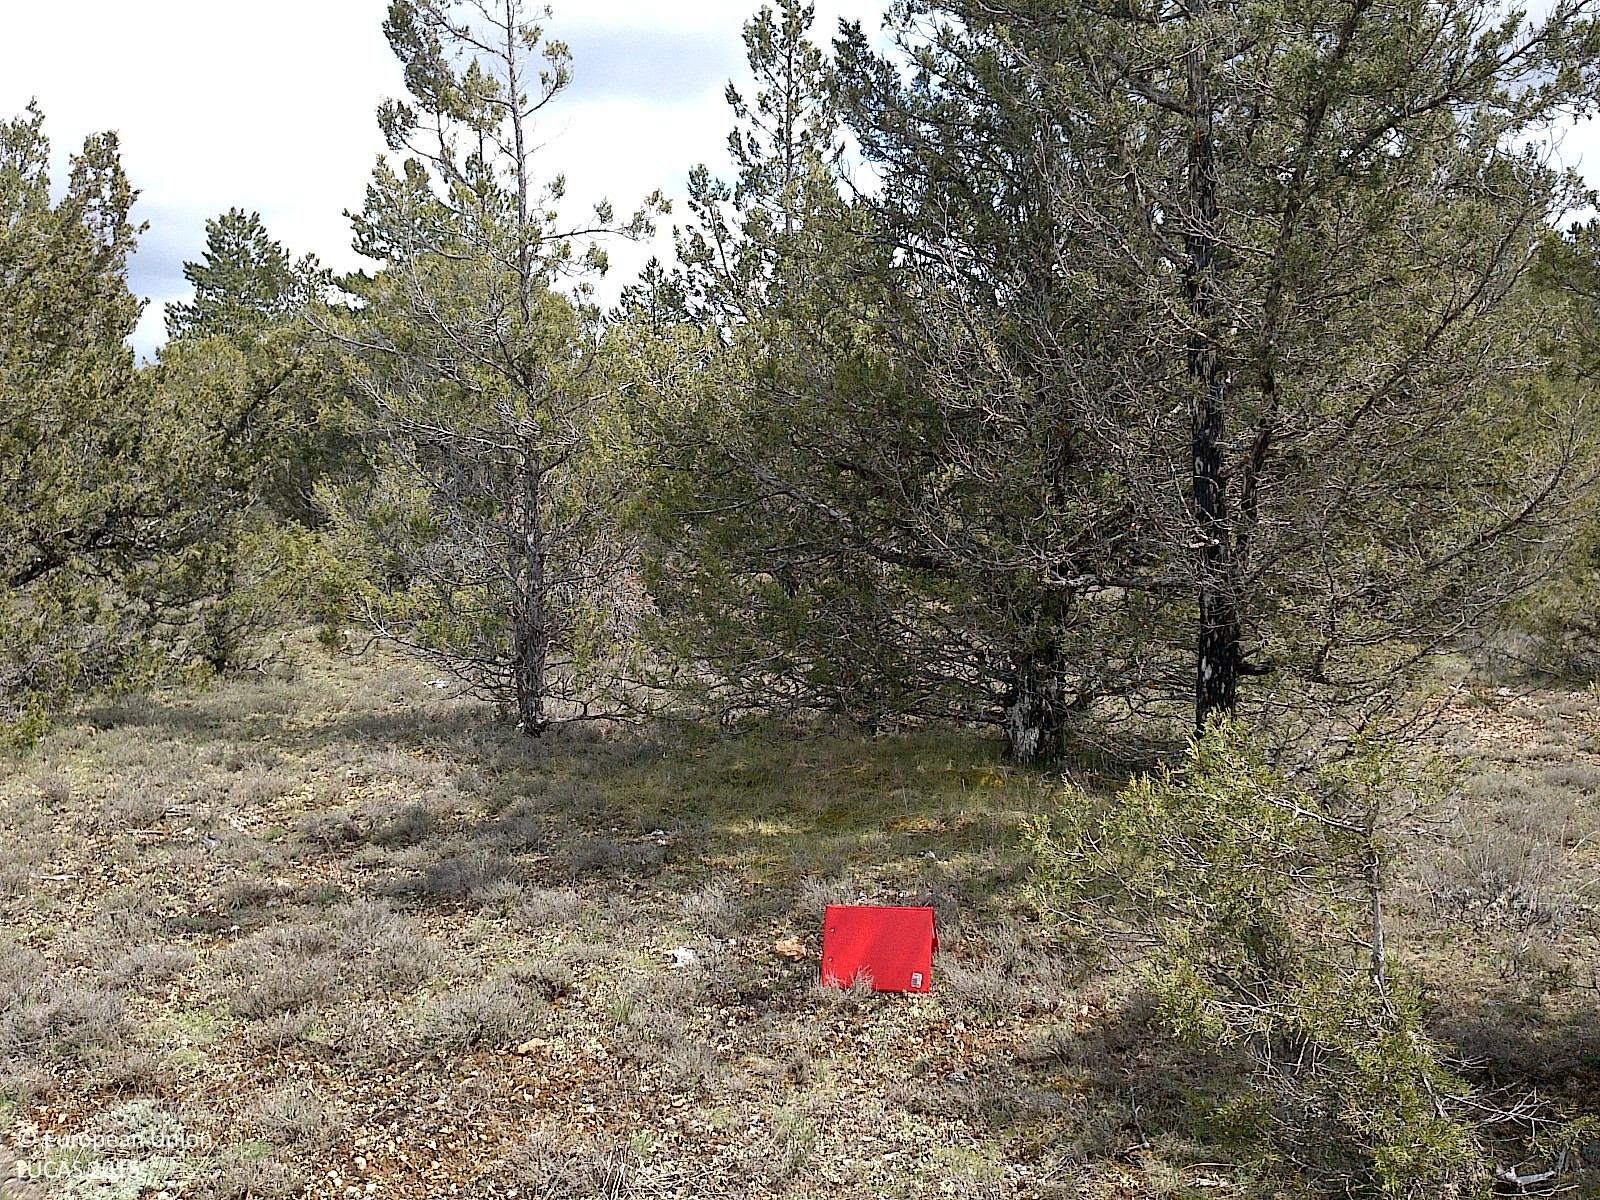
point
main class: Woodland
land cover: Other coniferous woodland
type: coniferous forest of the mediterranean region
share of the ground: 25 - 50 %
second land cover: Grassland without tree/shrub cover
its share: > 75 %
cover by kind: herbaceous plants 65 %, coniferous forest trees 35 %
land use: Forestry
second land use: Agriculture (excluding fallow land and kitchen gardens)
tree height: < 5 m
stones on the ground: 10 - 25 %
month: April
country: ES
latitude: 41.7646
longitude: -2.8043
